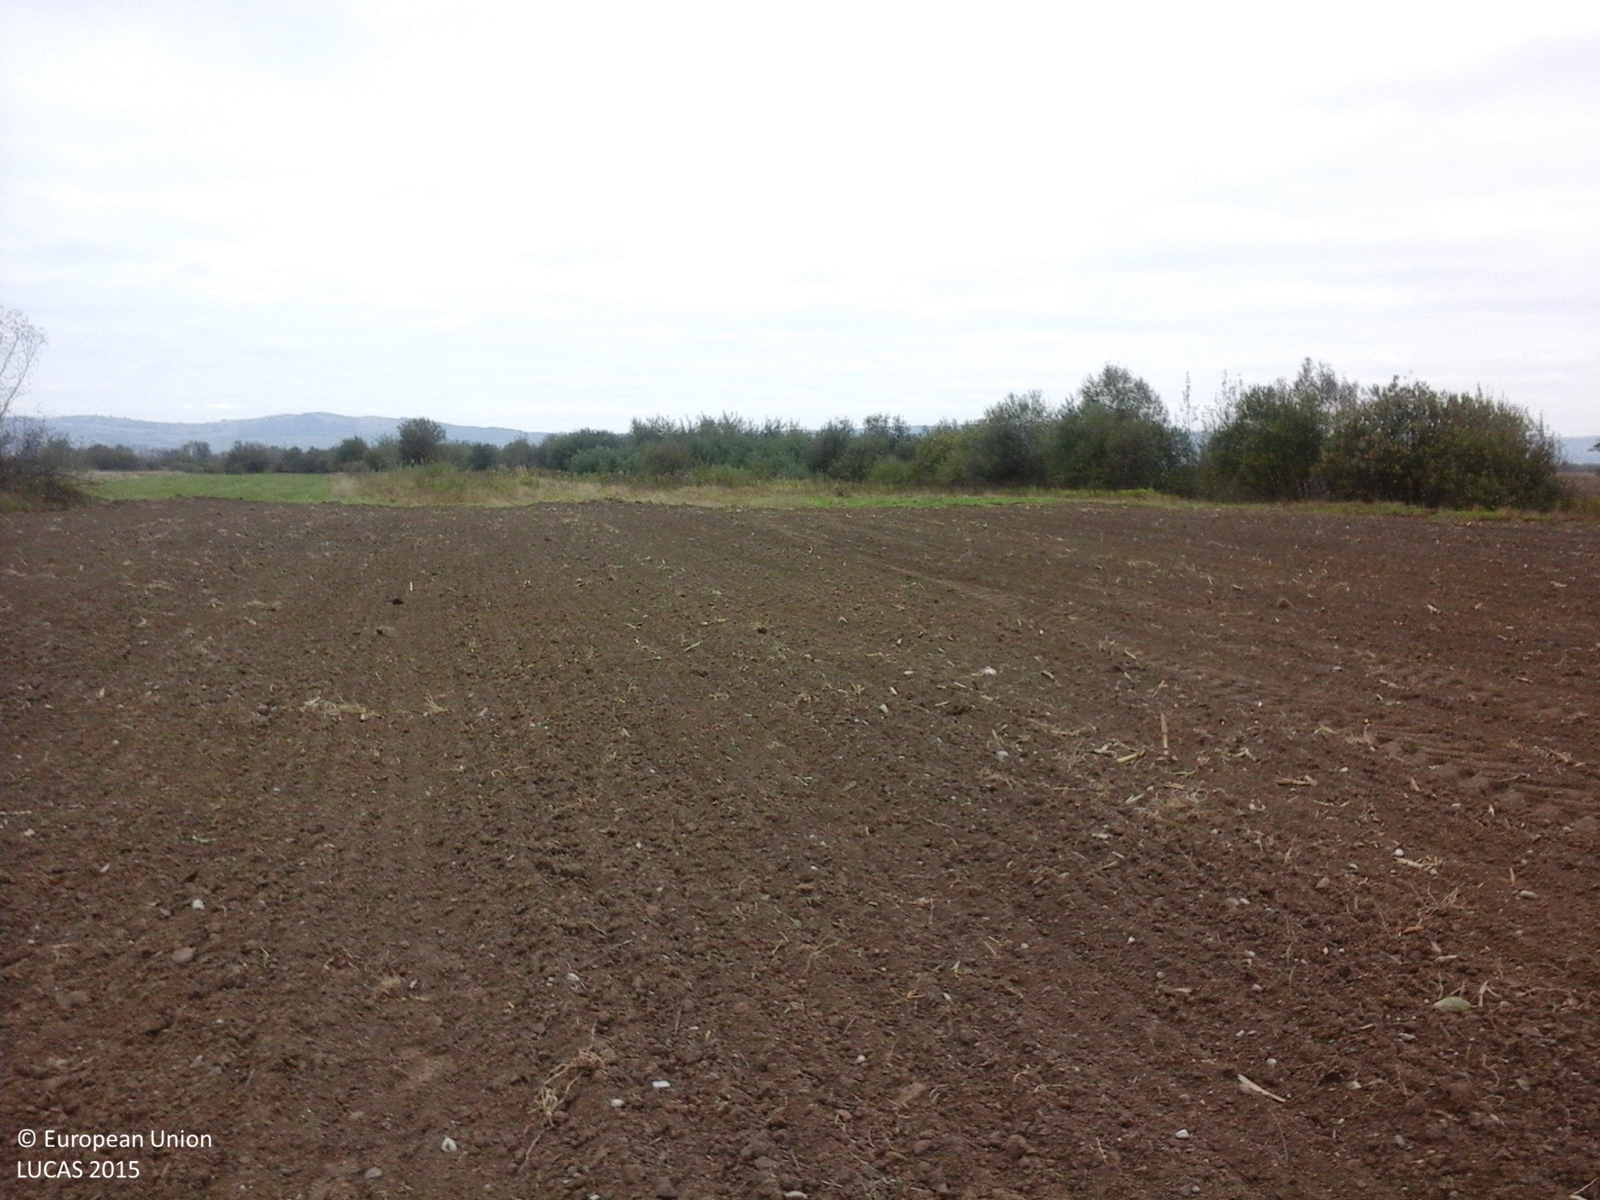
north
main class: Cropland
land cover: Maize
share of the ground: < 10 %
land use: Agriculture (excluding fallow land and kitchen gardens)
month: October
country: RO
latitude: 45.7913
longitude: 24.9228
